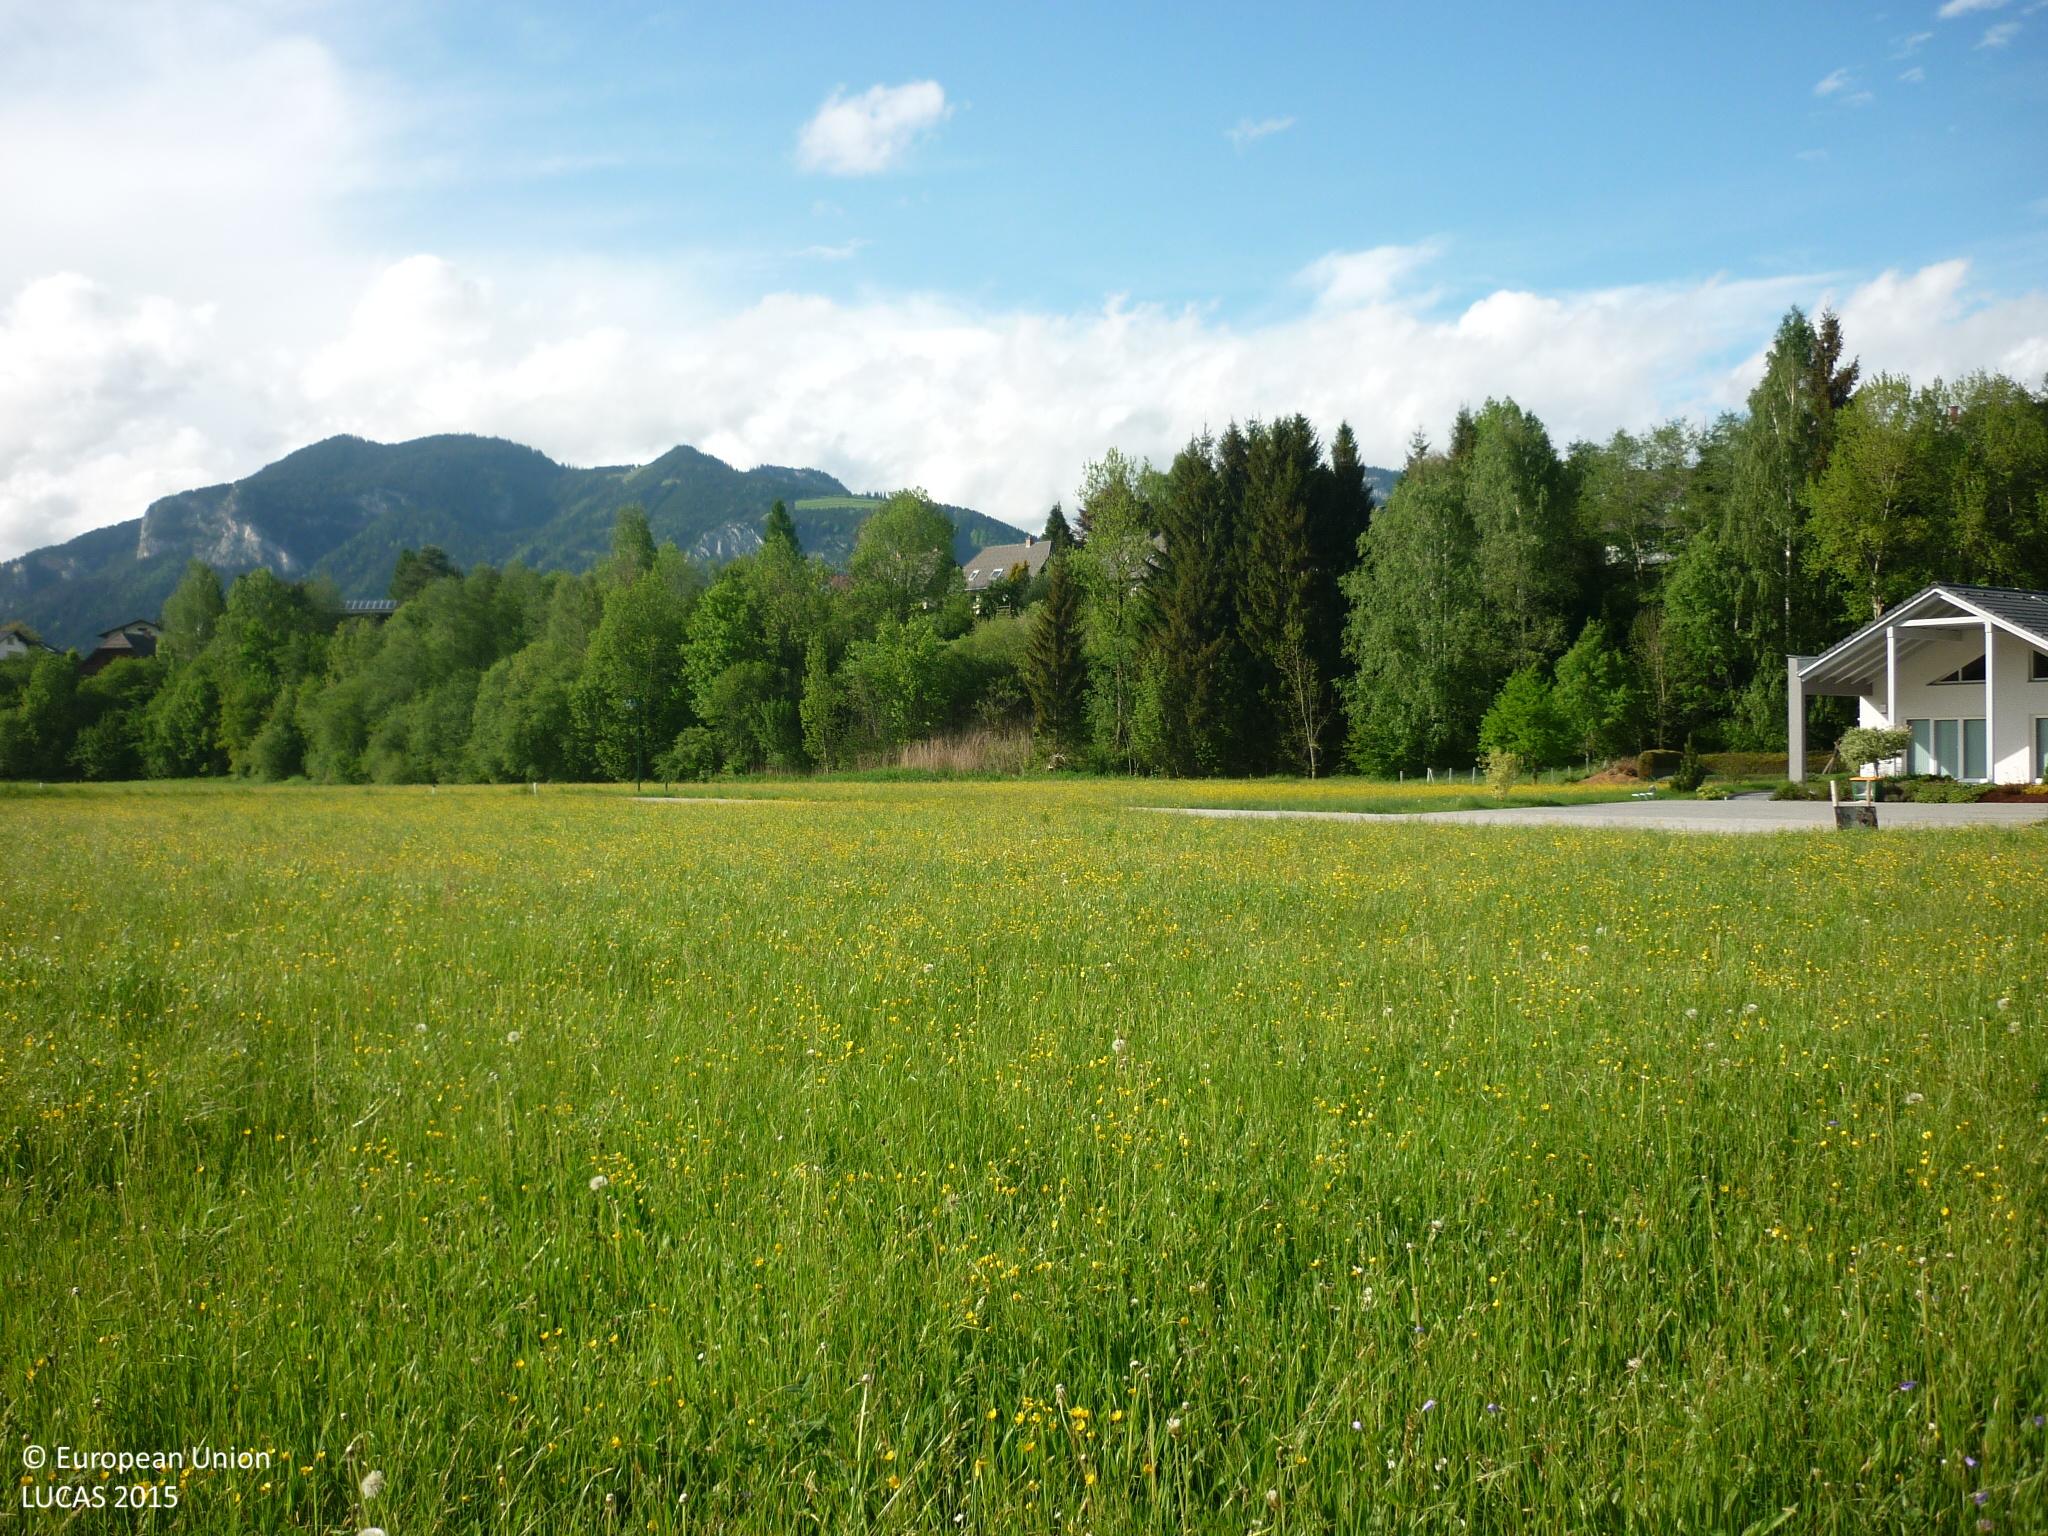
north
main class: Grassland
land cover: Grassland without tree/shrub cover
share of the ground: > 75 %
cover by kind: herbaceous plants 100 %
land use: Agriculture (excluding fallow land and kitchen gardens)
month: May
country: AT
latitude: 47.4986
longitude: 14.1007
